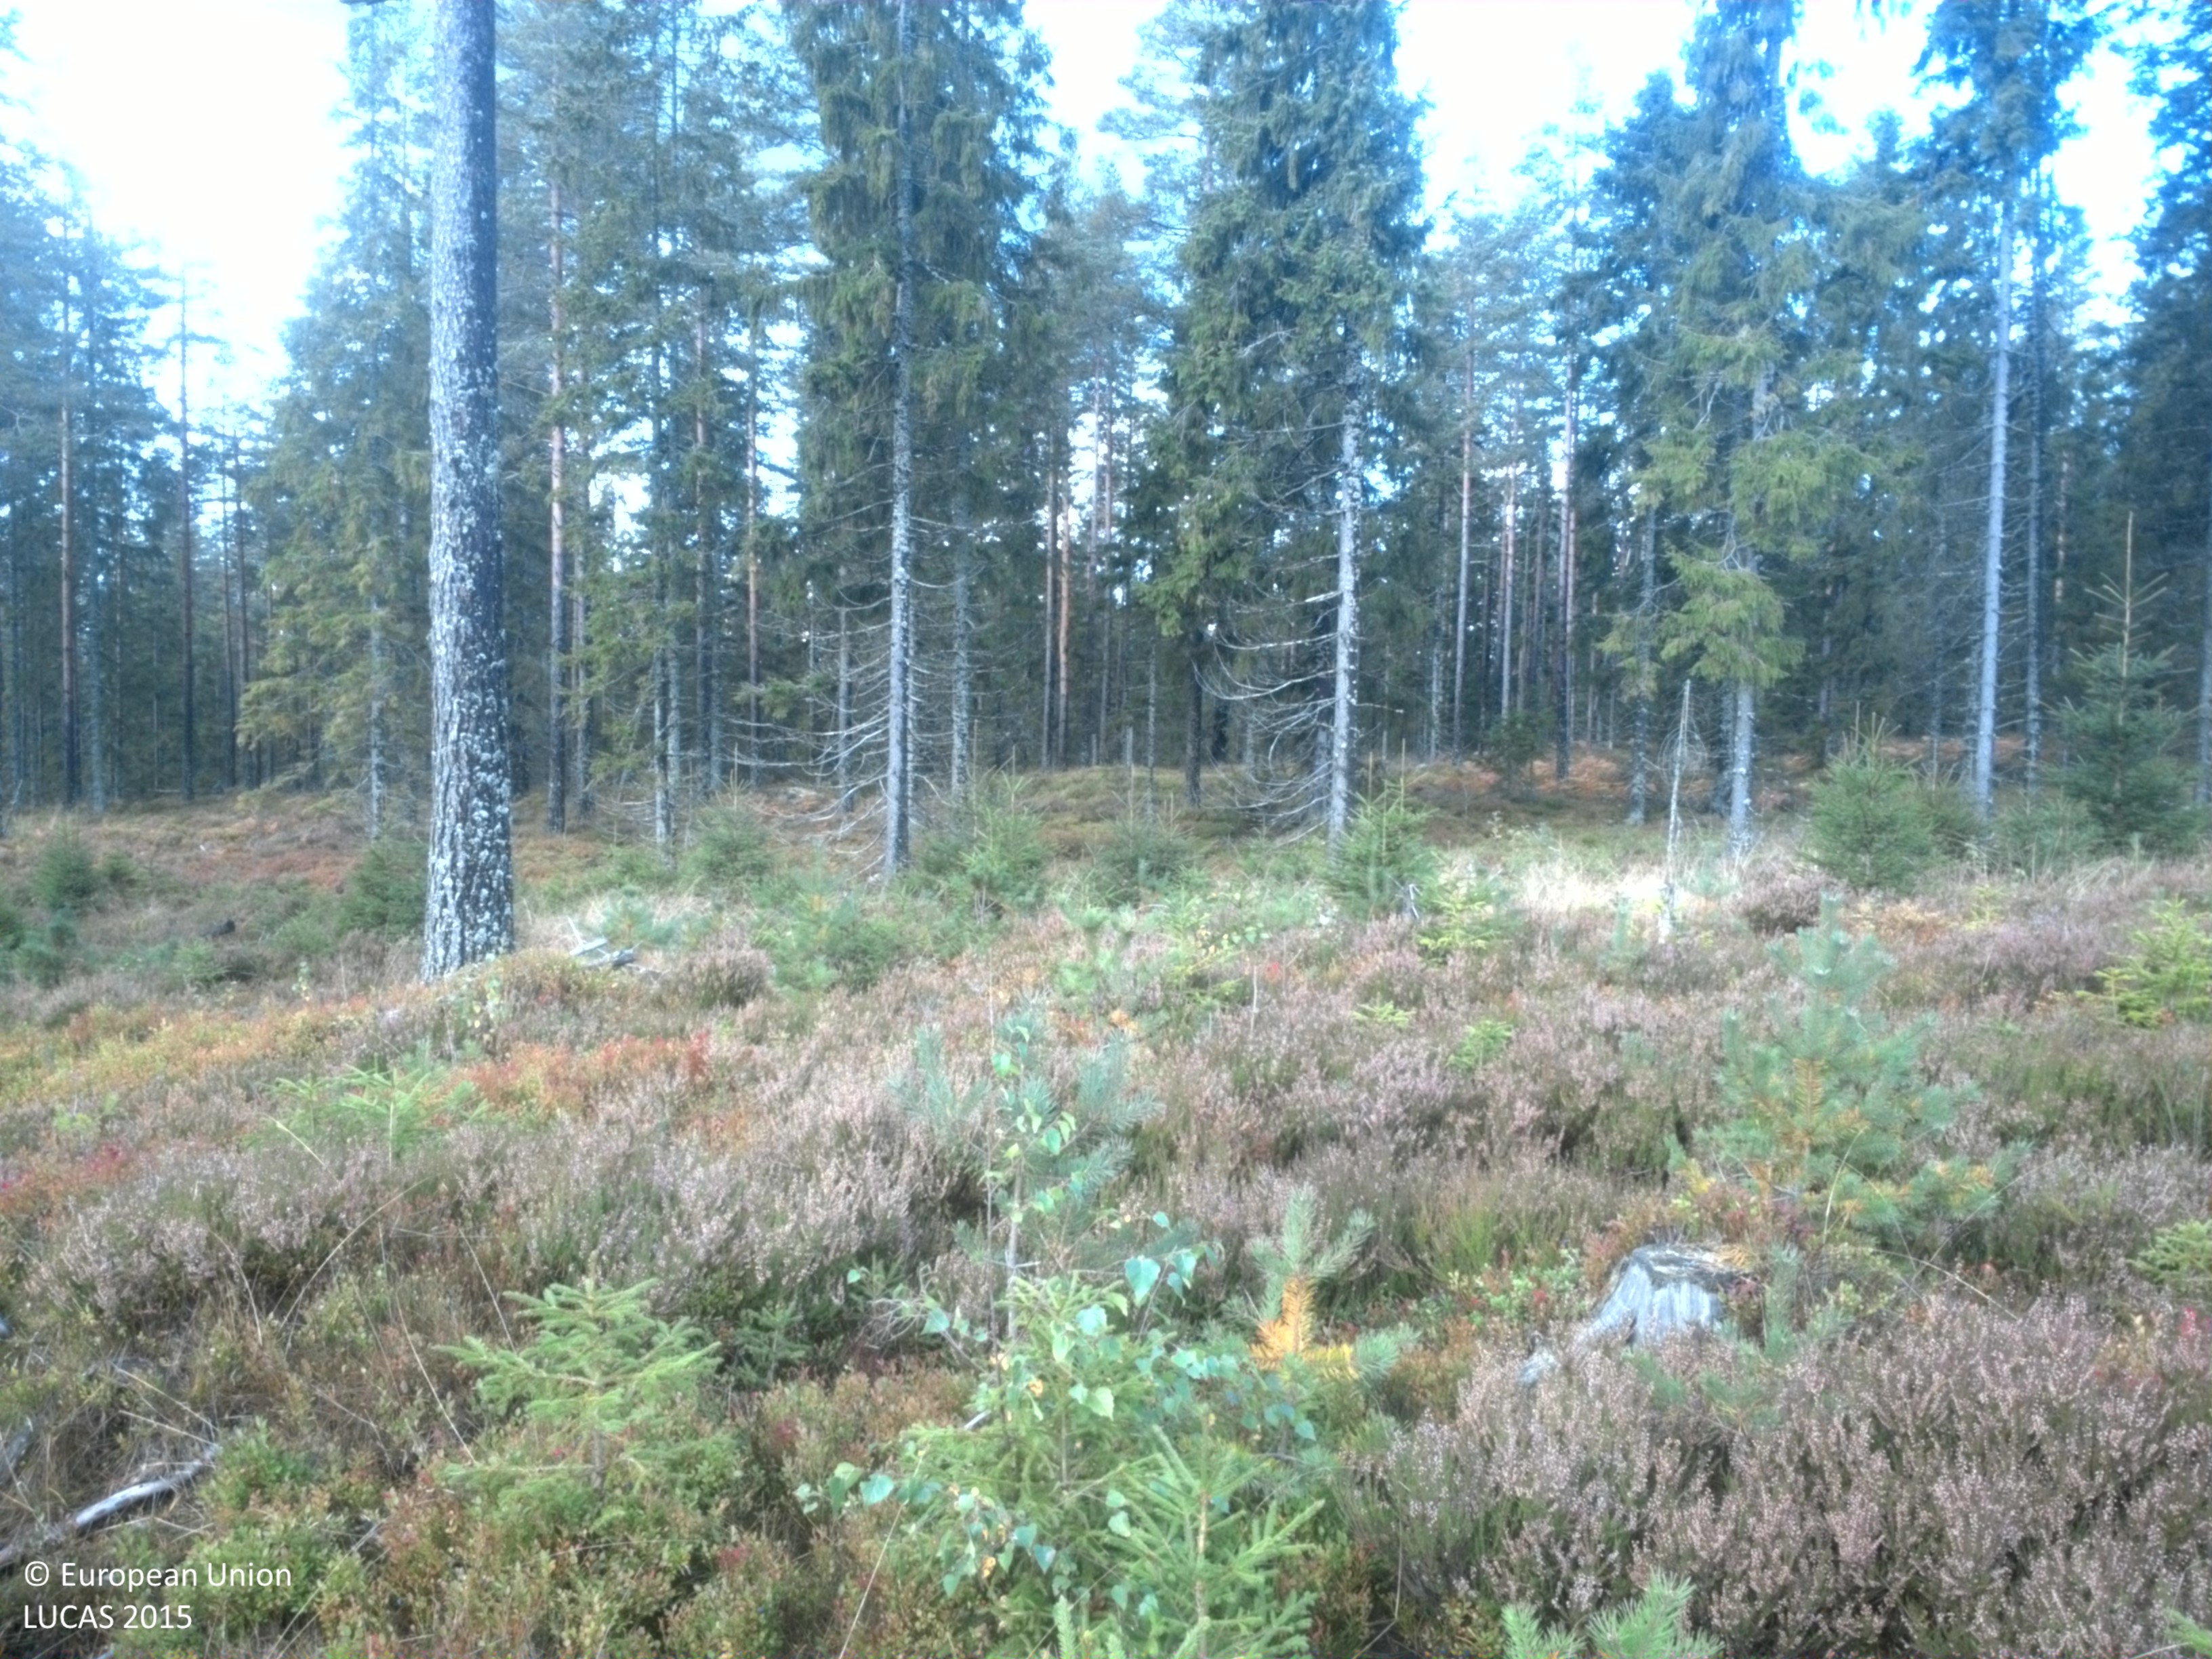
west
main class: Woodland
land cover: Other coniferous woodland
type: boreal forest
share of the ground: 50 - 75 %
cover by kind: coniferous forest trees 60 %, shrubs 30 %, herbaceous plants 10 %
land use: Forestry
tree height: > 5 m
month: September
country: SE
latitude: 59.8566
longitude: 15.5065
